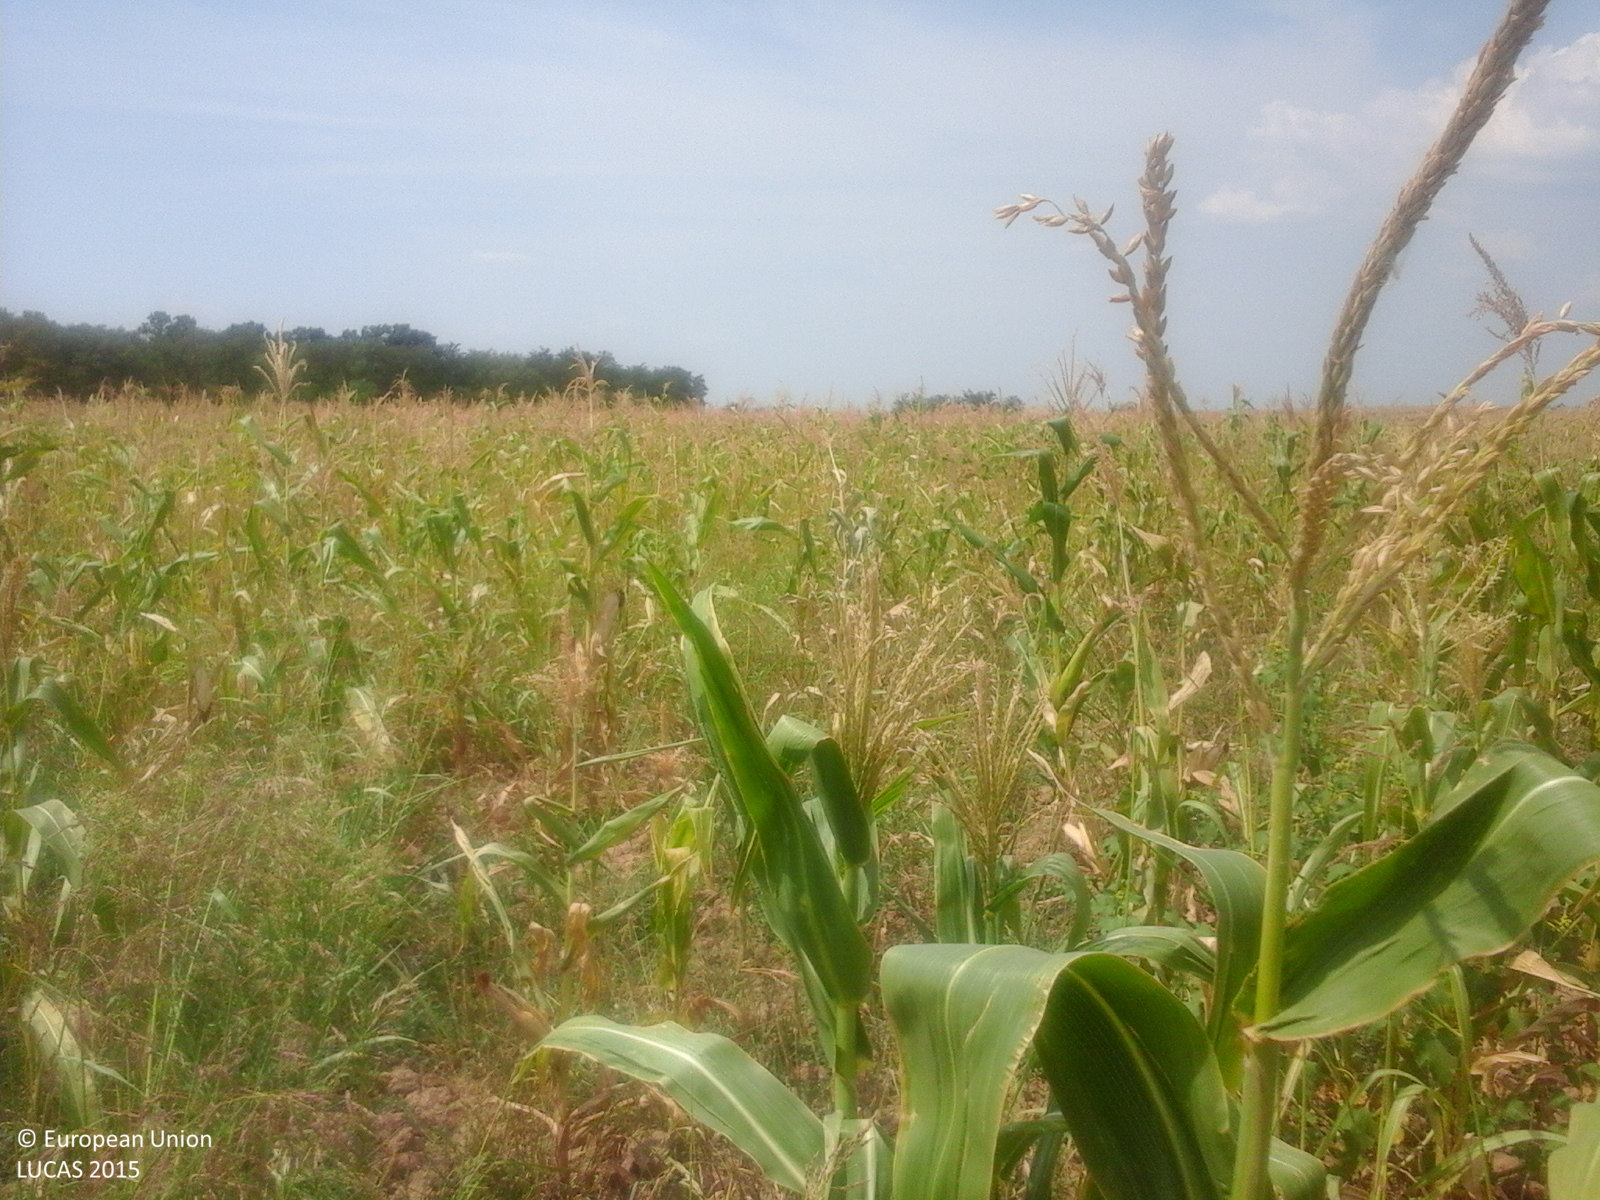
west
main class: Cropland
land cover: Maize
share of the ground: > 75 %
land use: Agriculture (excluding fallow land and kitchen gardens)
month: August
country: RO
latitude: 44.3212
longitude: 22.7929
